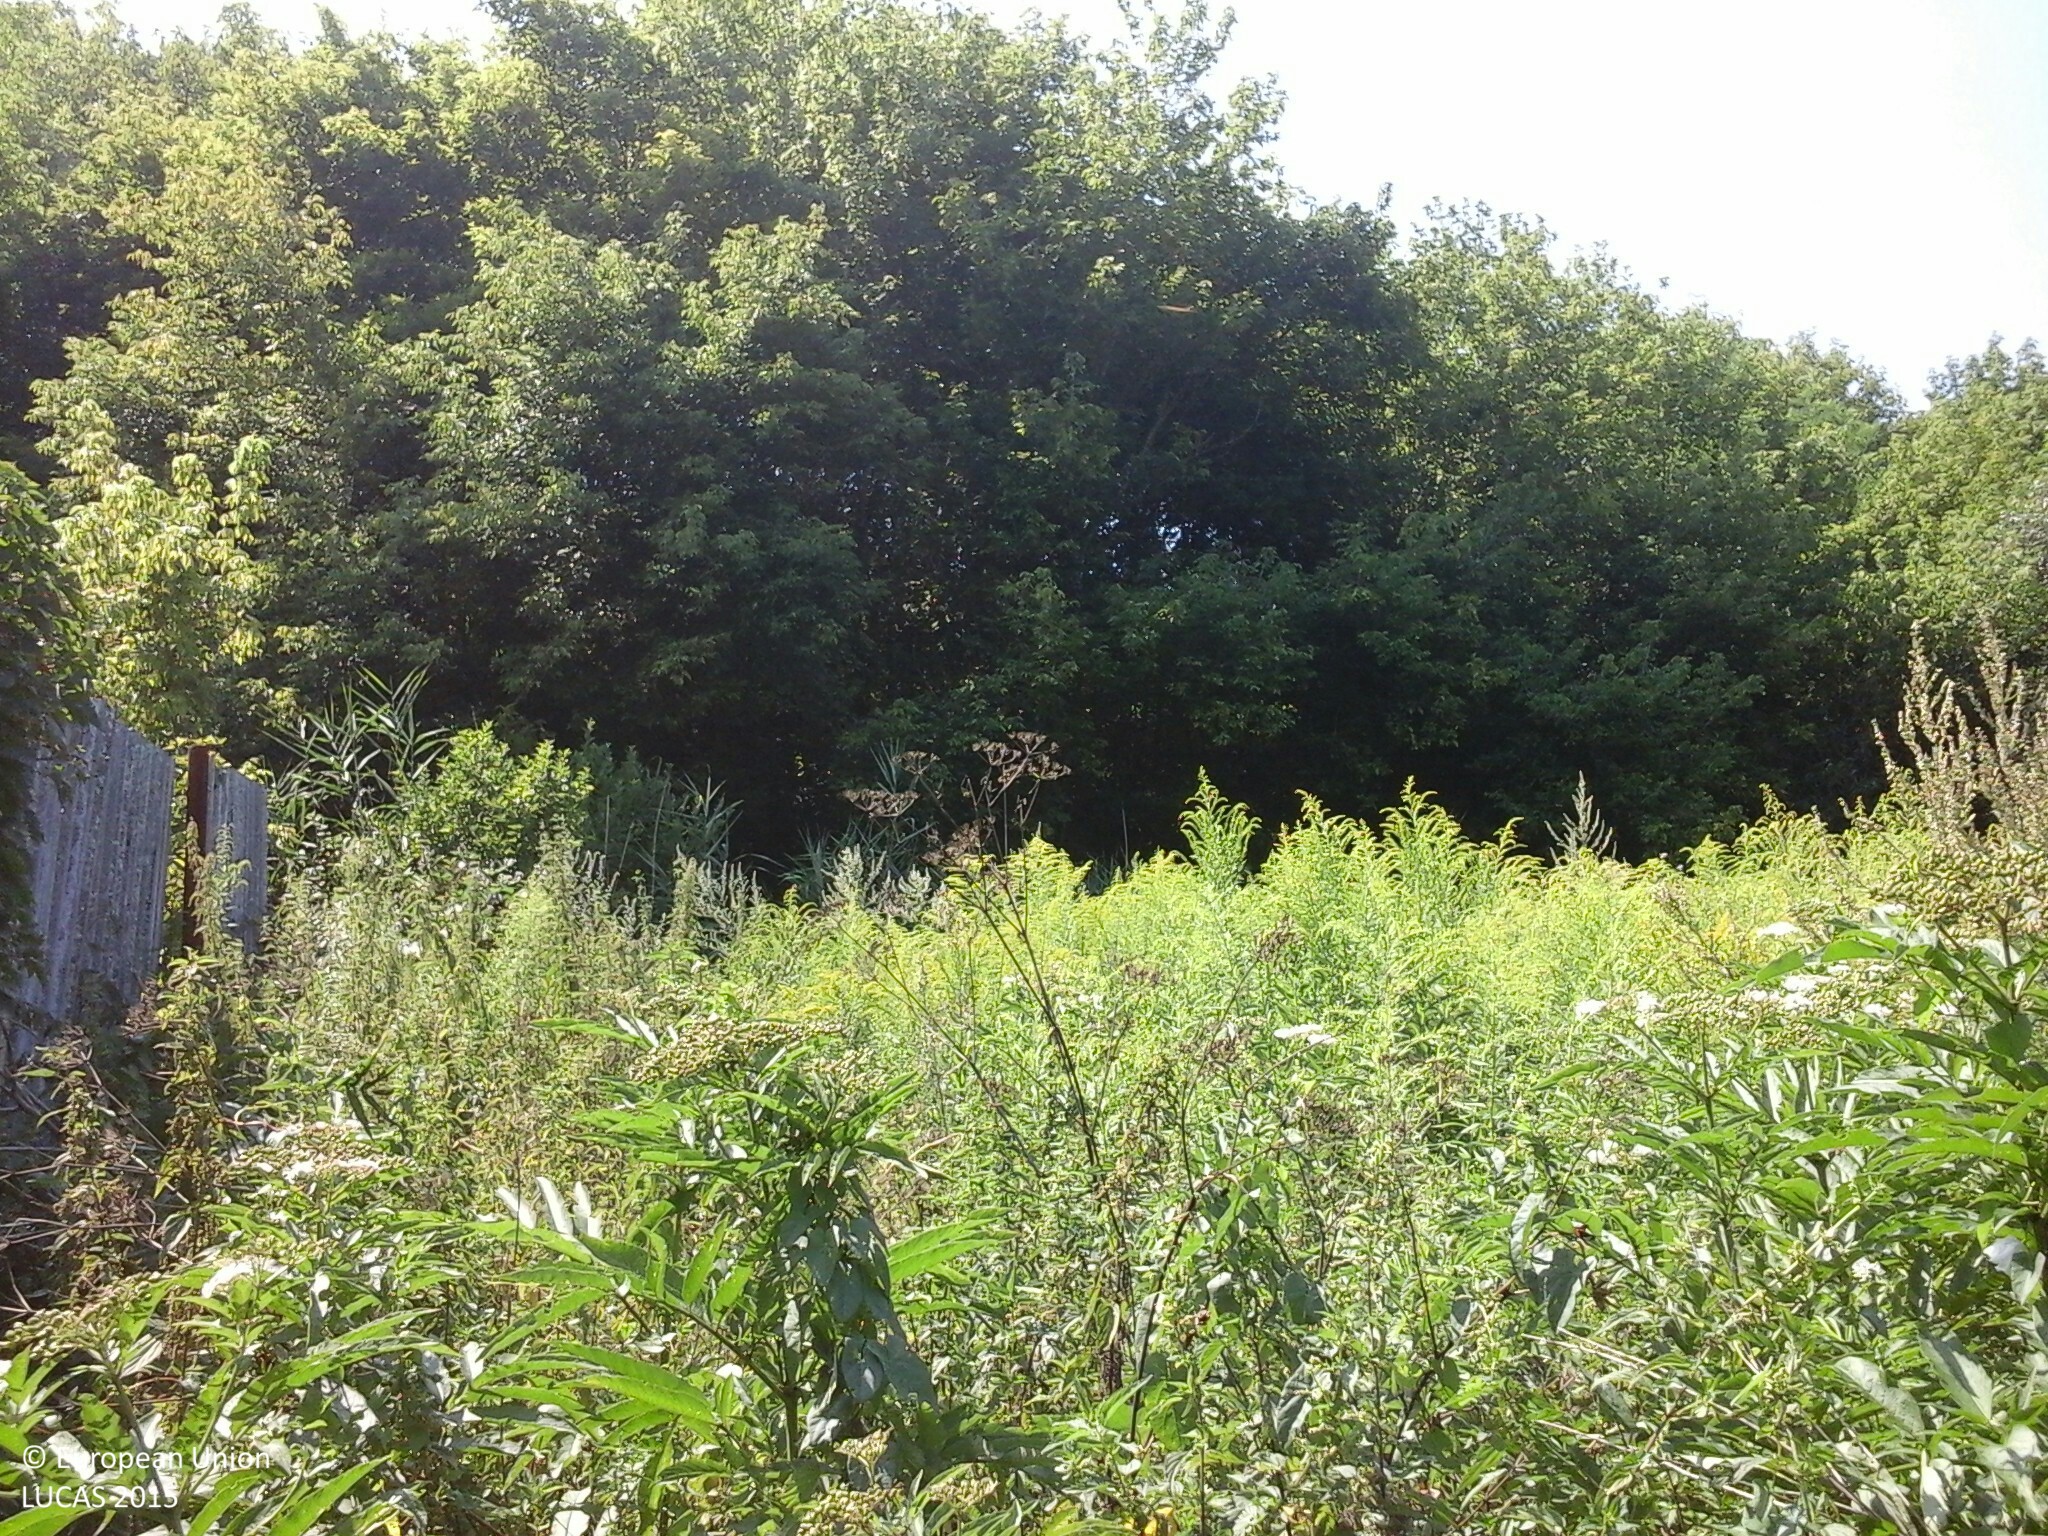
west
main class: Grassland
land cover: Grassland with sparse tree/shrub cover
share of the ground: > 75 %
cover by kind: herbaceous plants 95 %, broadleaved forest trees 5 %
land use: Semi-natural and natural areas not in use
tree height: < 5 m
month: August
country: HU
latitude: 48.1658
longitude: 20.3992
